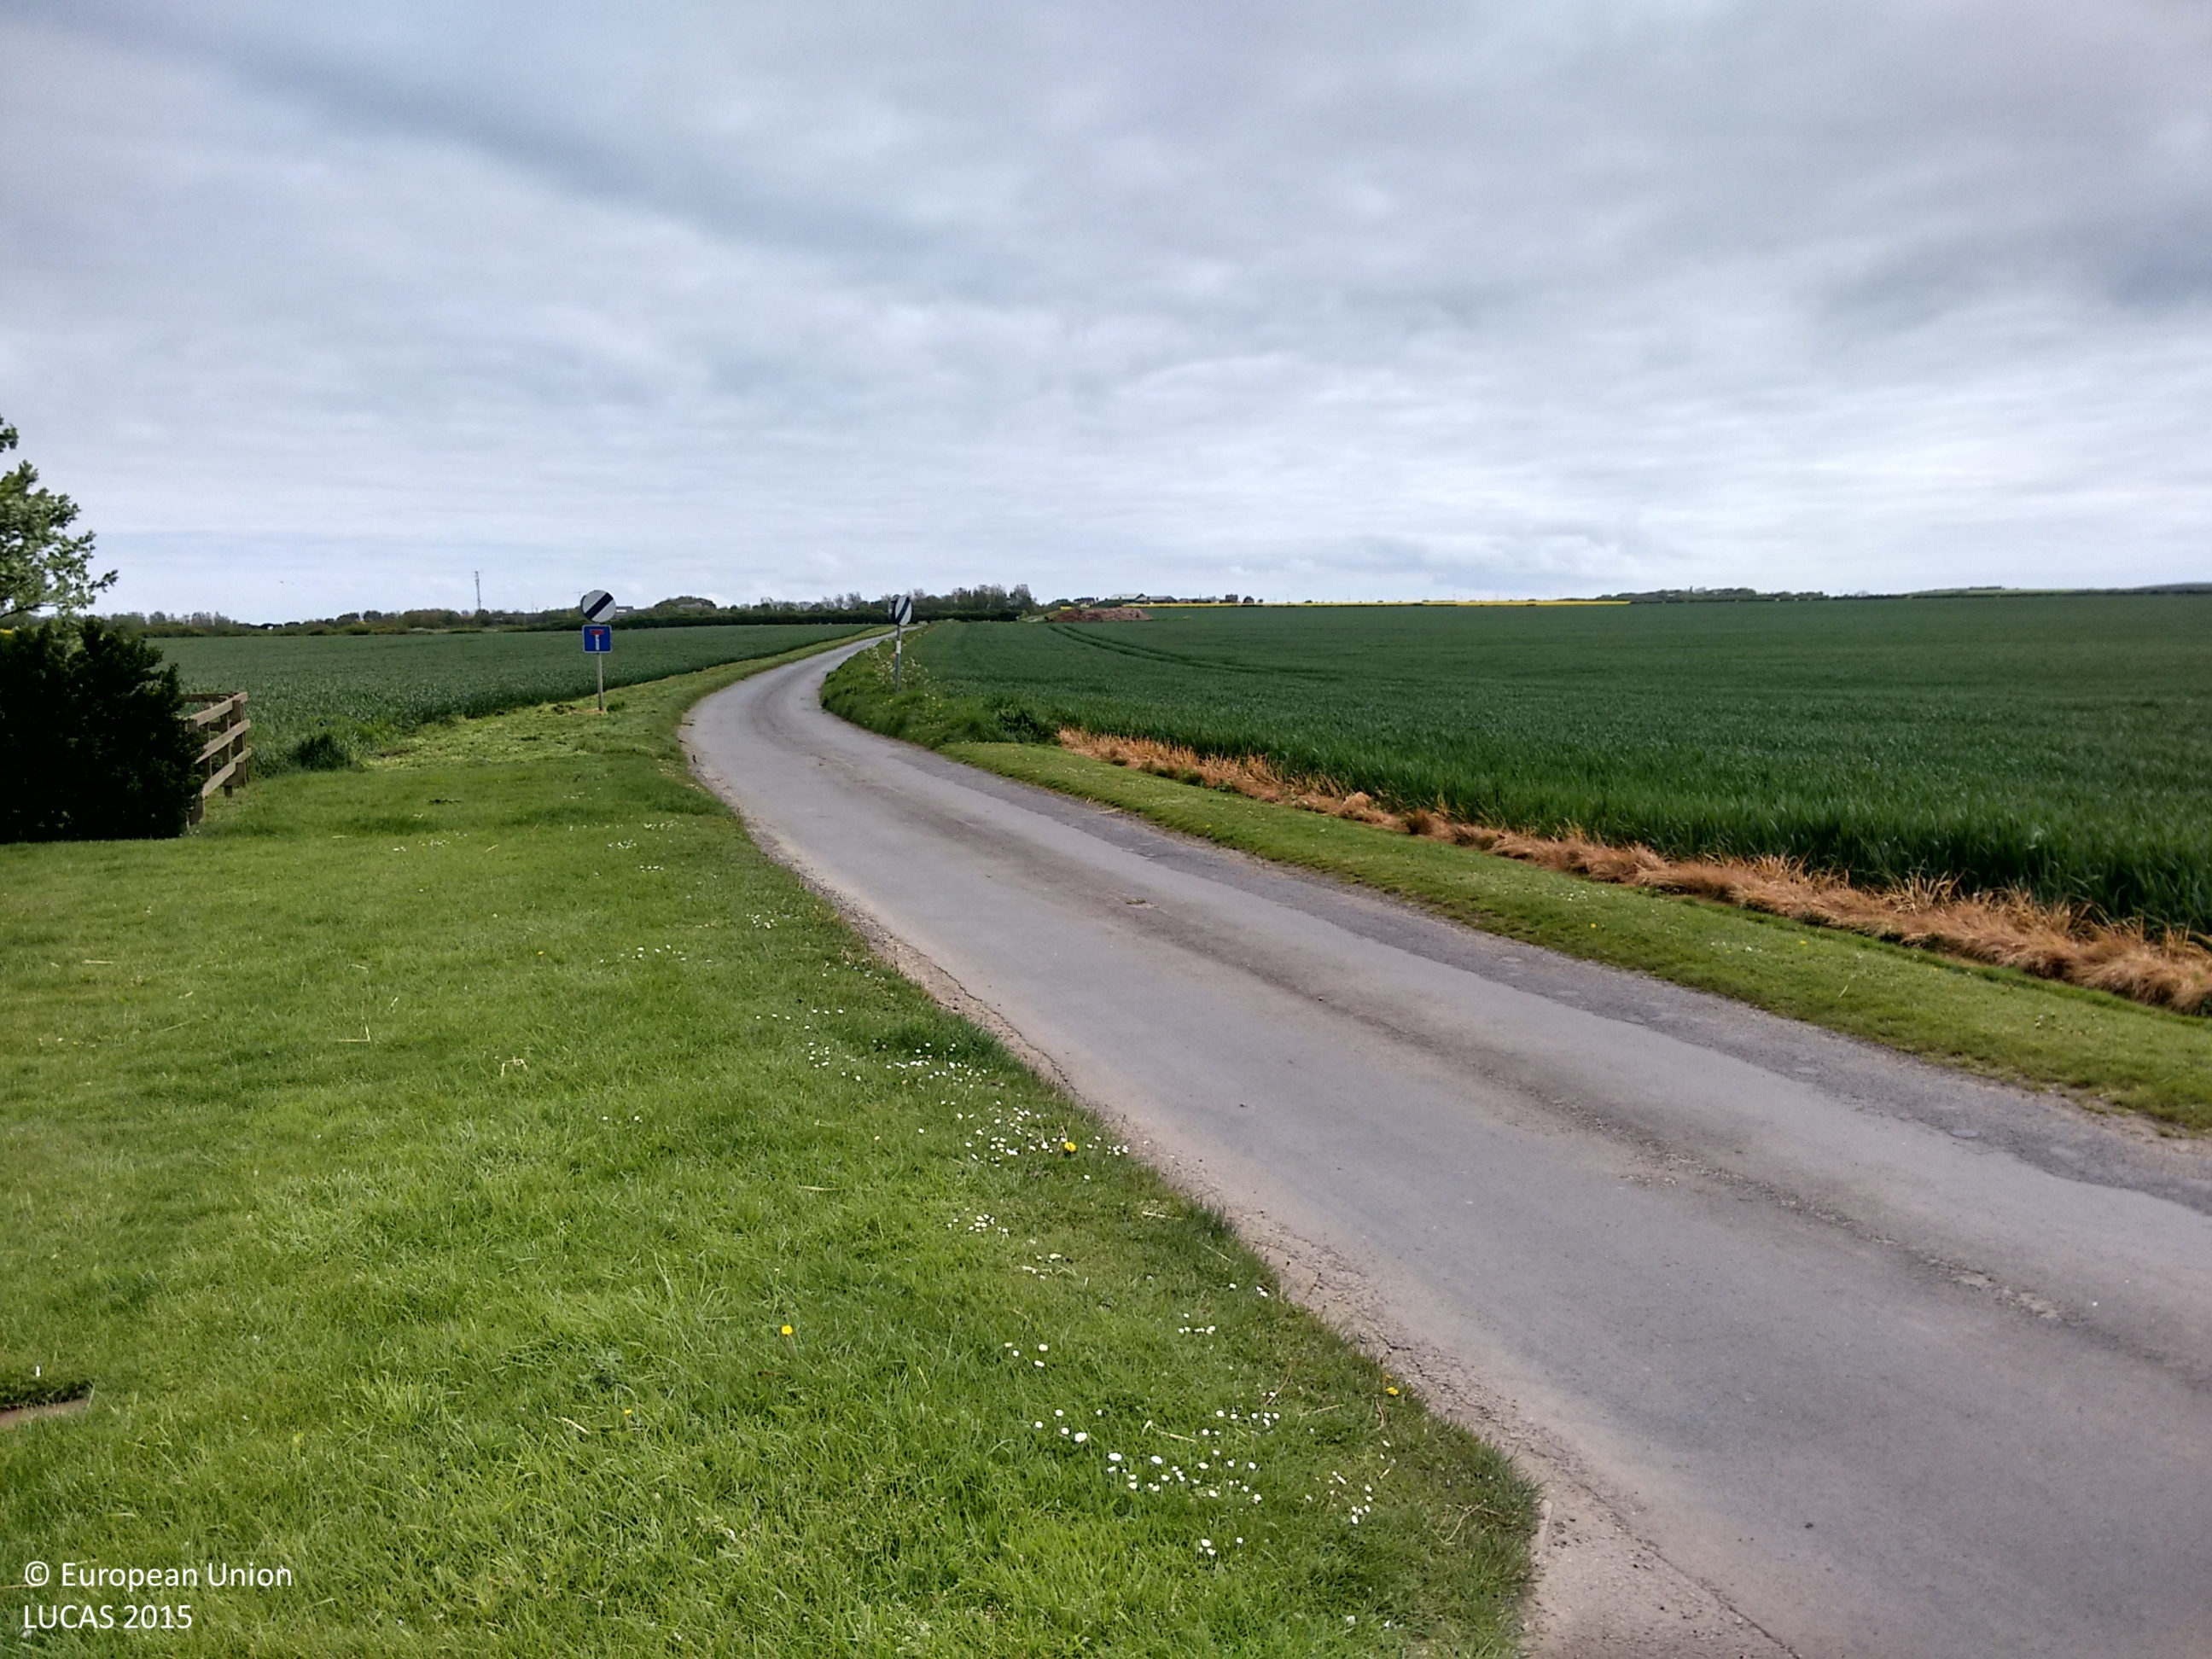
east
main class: Grassland
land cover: Grassland without tree/shrub cover
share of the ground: > 75 %
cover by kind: herbaceous plants 100 %
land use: Residential
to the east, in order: Grassland without tree/shrub cover; Artificial constructions in urban areas; Common wheat
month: May
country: GB
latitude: 53.8299
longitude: -0.1058
